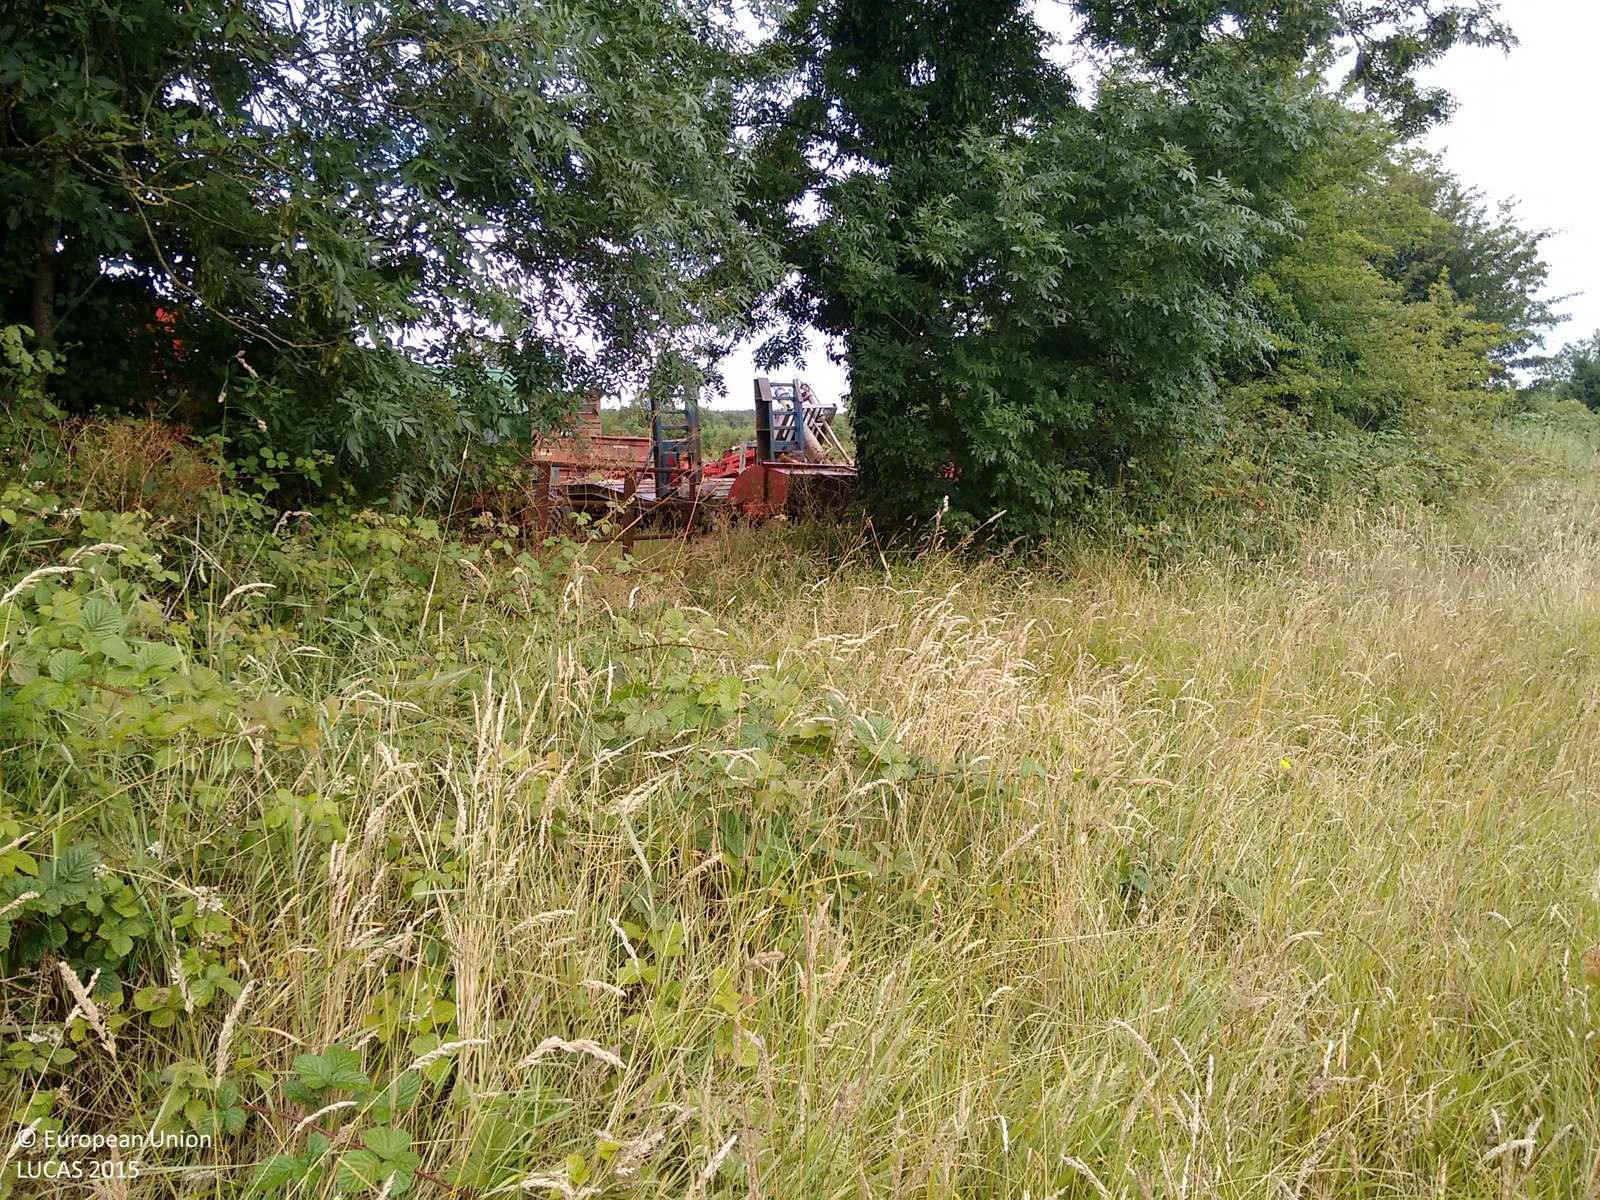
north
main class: Grassland
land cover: Grassland without tree/shrub cover
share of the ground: > 75 %
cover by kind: herbaceous plants 100 %
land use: Agriculture (excluding fallow land and kitchen gardens)
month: July
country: IE
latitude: 53.6933
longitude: -7.7802
